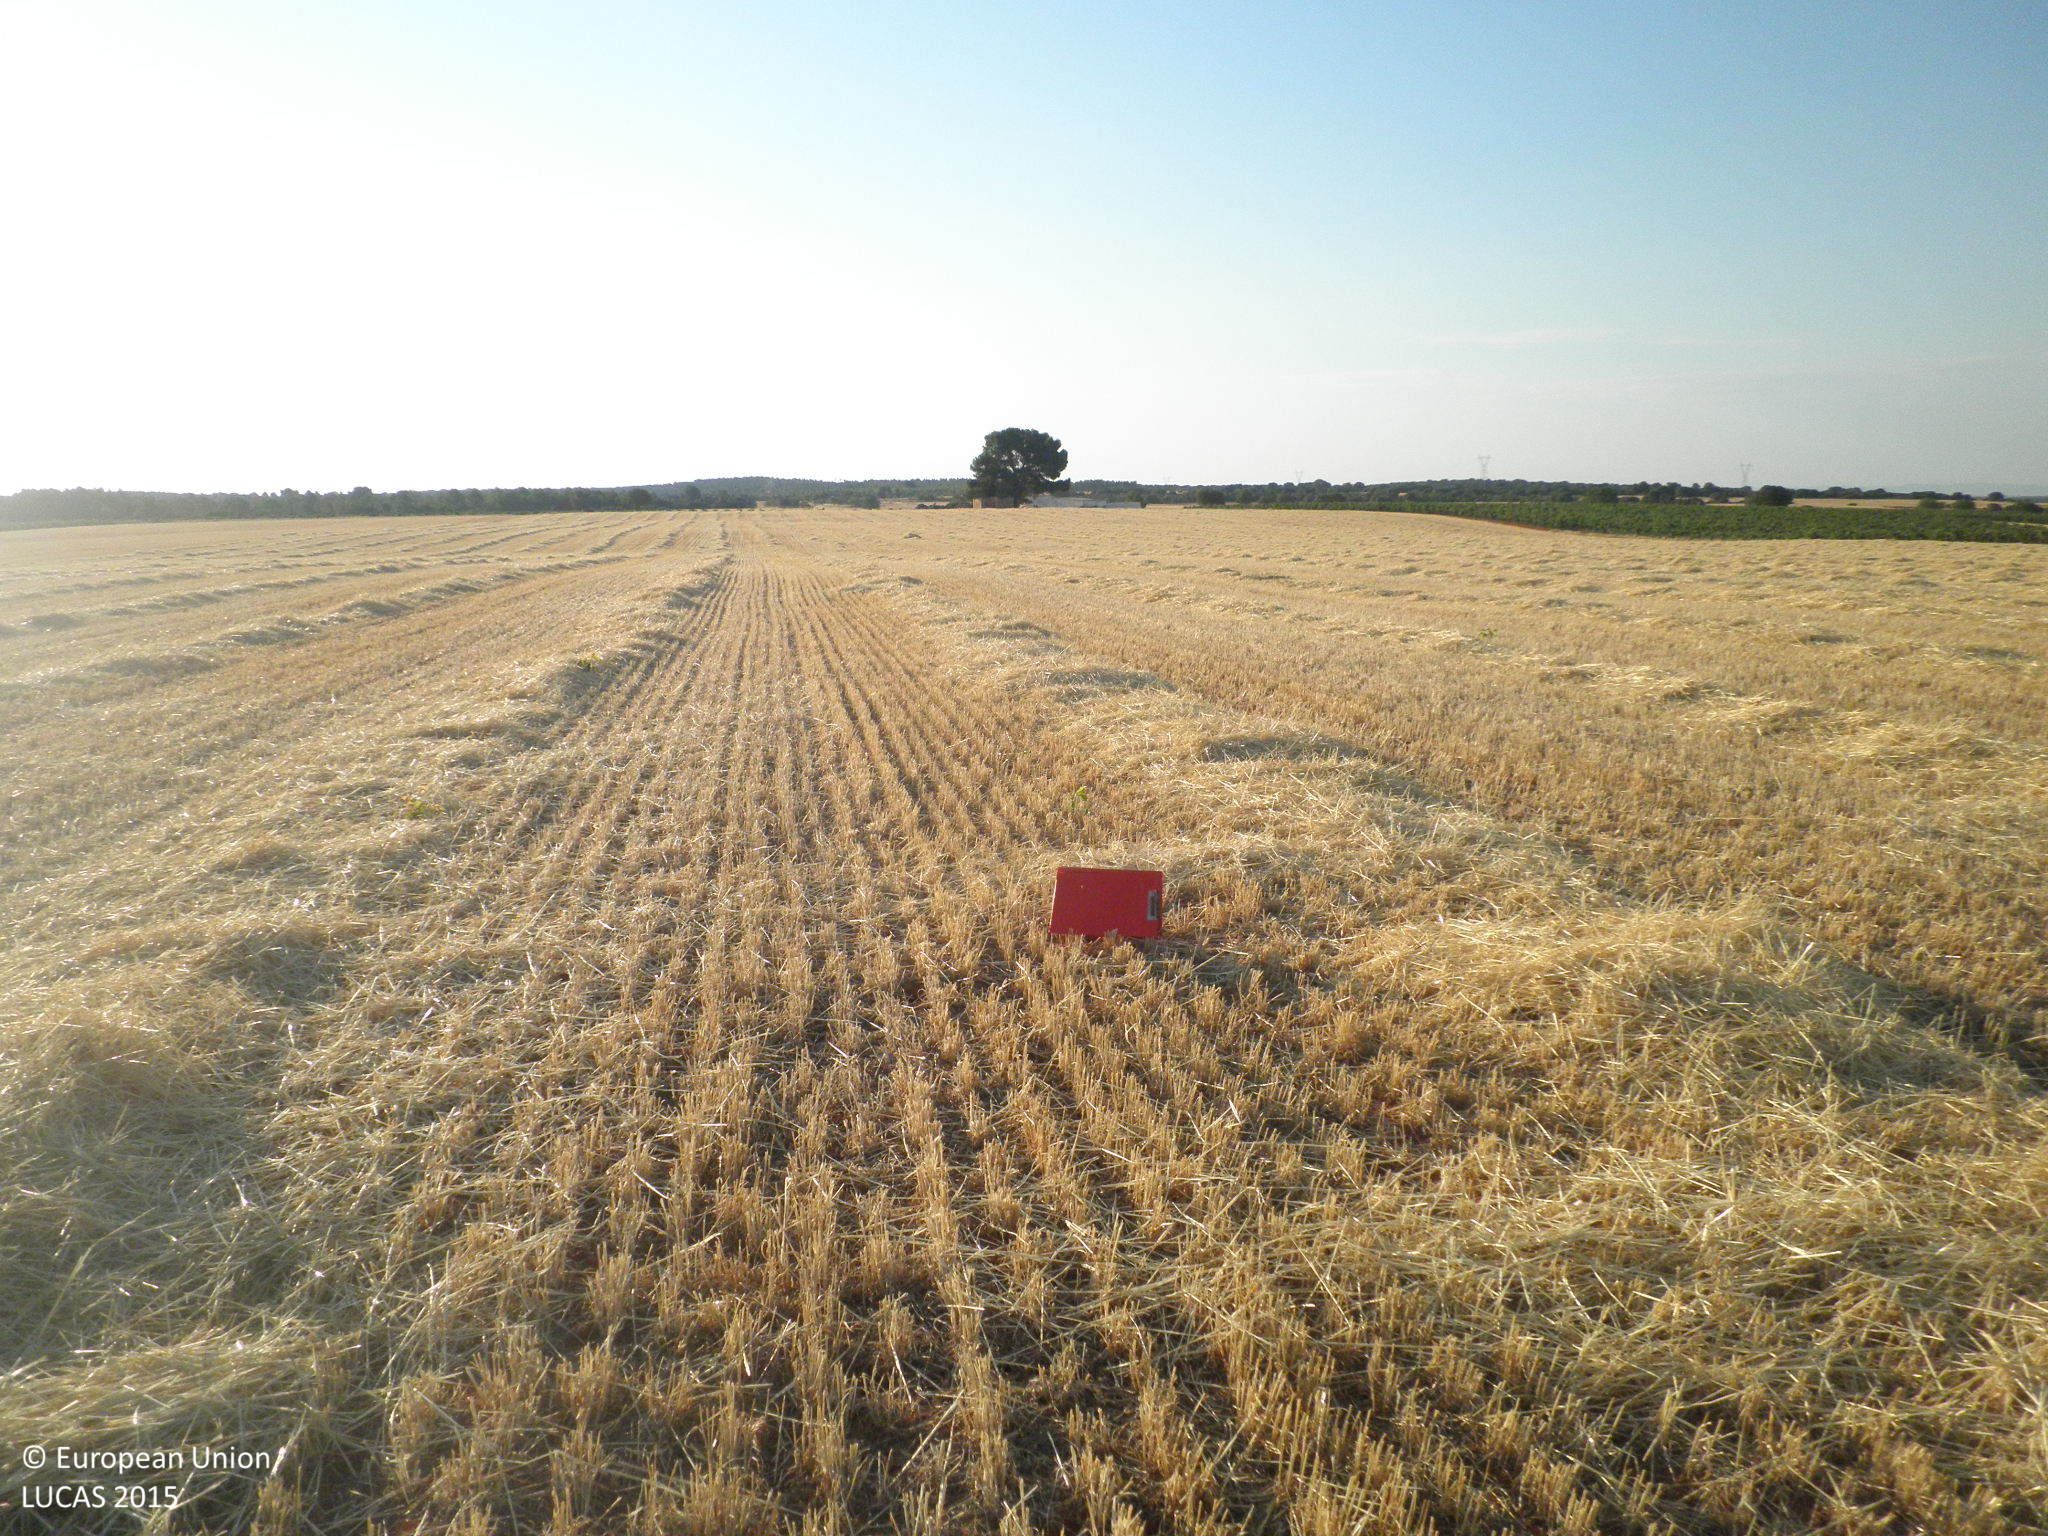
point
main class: Cropland
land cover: Barley
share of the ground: < 10 %
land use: Agriculture (excluding fallow land and kitchen gardens)
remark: Harvested field
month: July
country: ES
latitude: 39.5475
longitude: -1.8418
